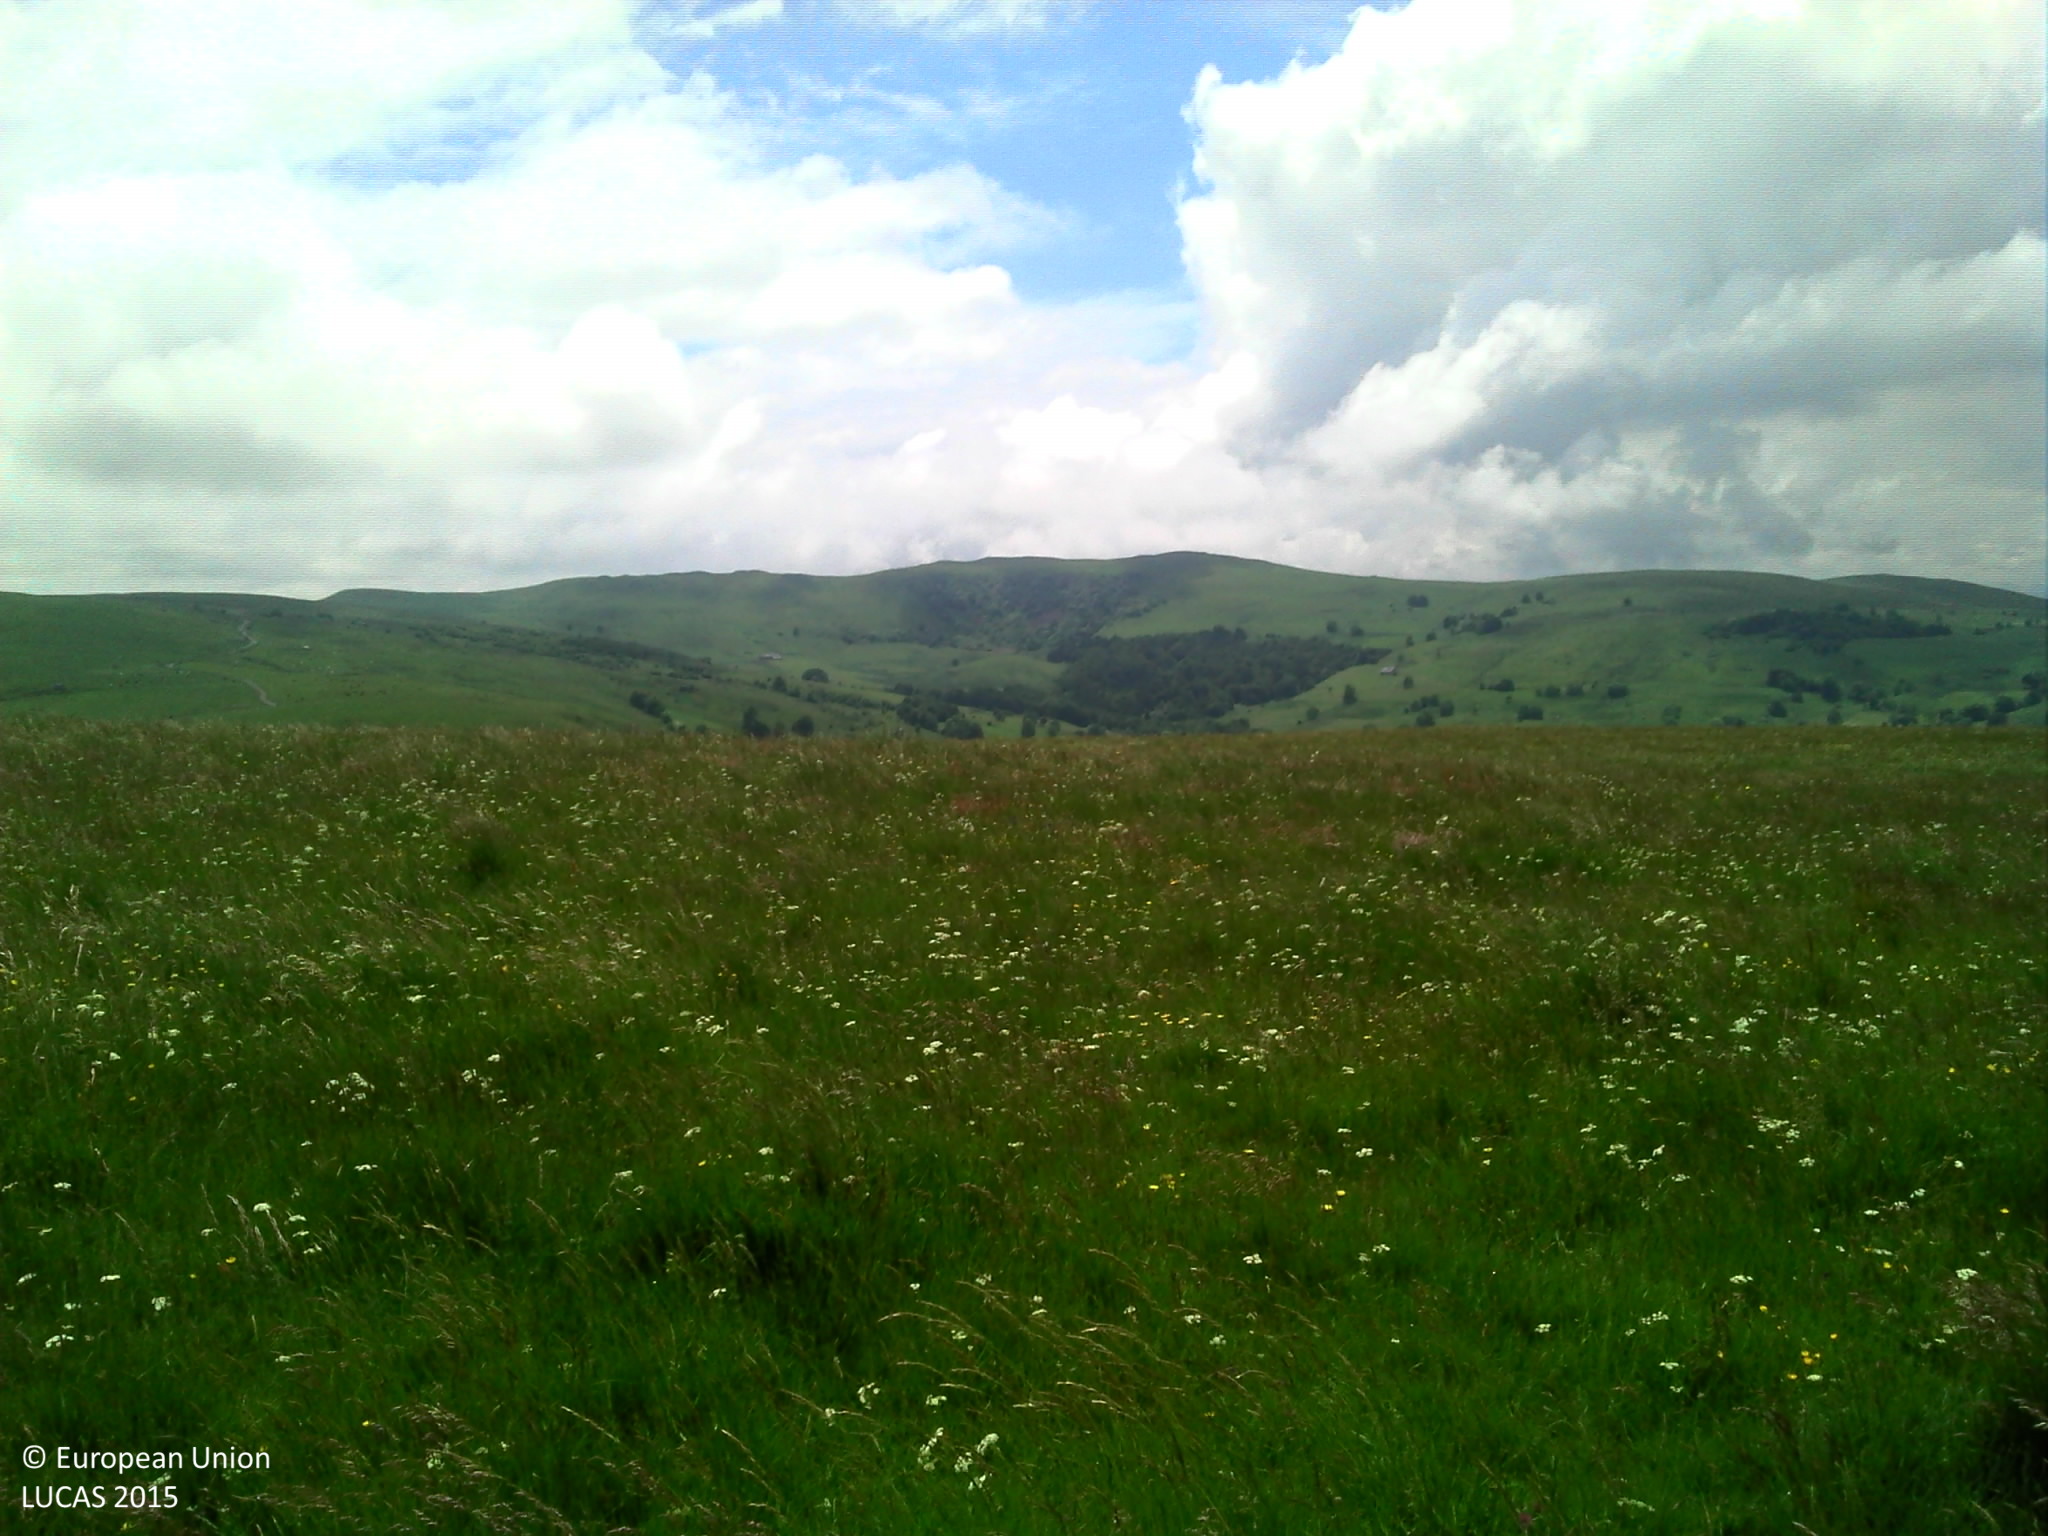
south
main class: Grassland
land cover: Grassland without tree/shrub cover
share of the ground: > 75 %
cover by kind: herbaceous plants 100 %
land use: Agriculture (excluding fallow land and kitchen gardens)
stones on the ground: < 10 %
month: June
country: FR
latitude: 45.3371
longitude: 2.8927
